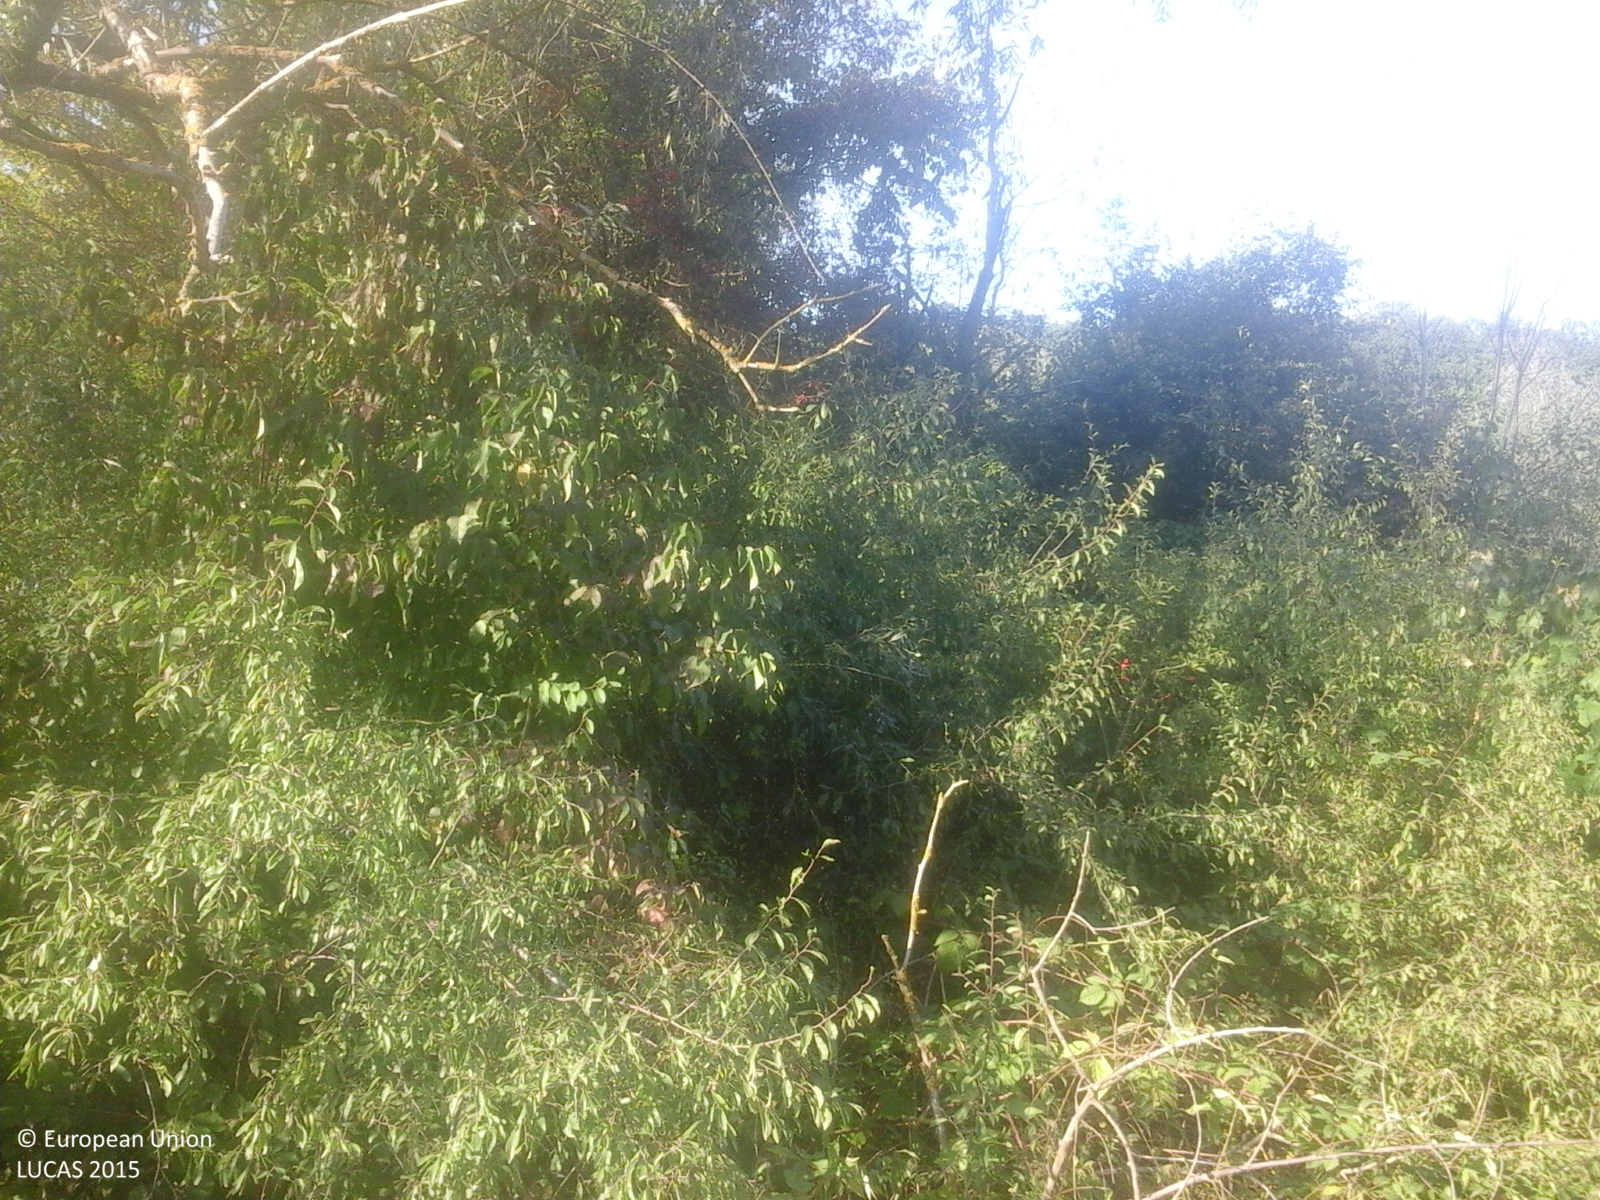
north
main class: Woodland
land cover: Broadleaved woodland
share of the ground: > 75 %
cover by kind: broadleaved forest trees 100 %
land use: Semi-natural and natural areas not in use
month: September
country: RO
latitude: 46.8867
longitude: 23.2816
